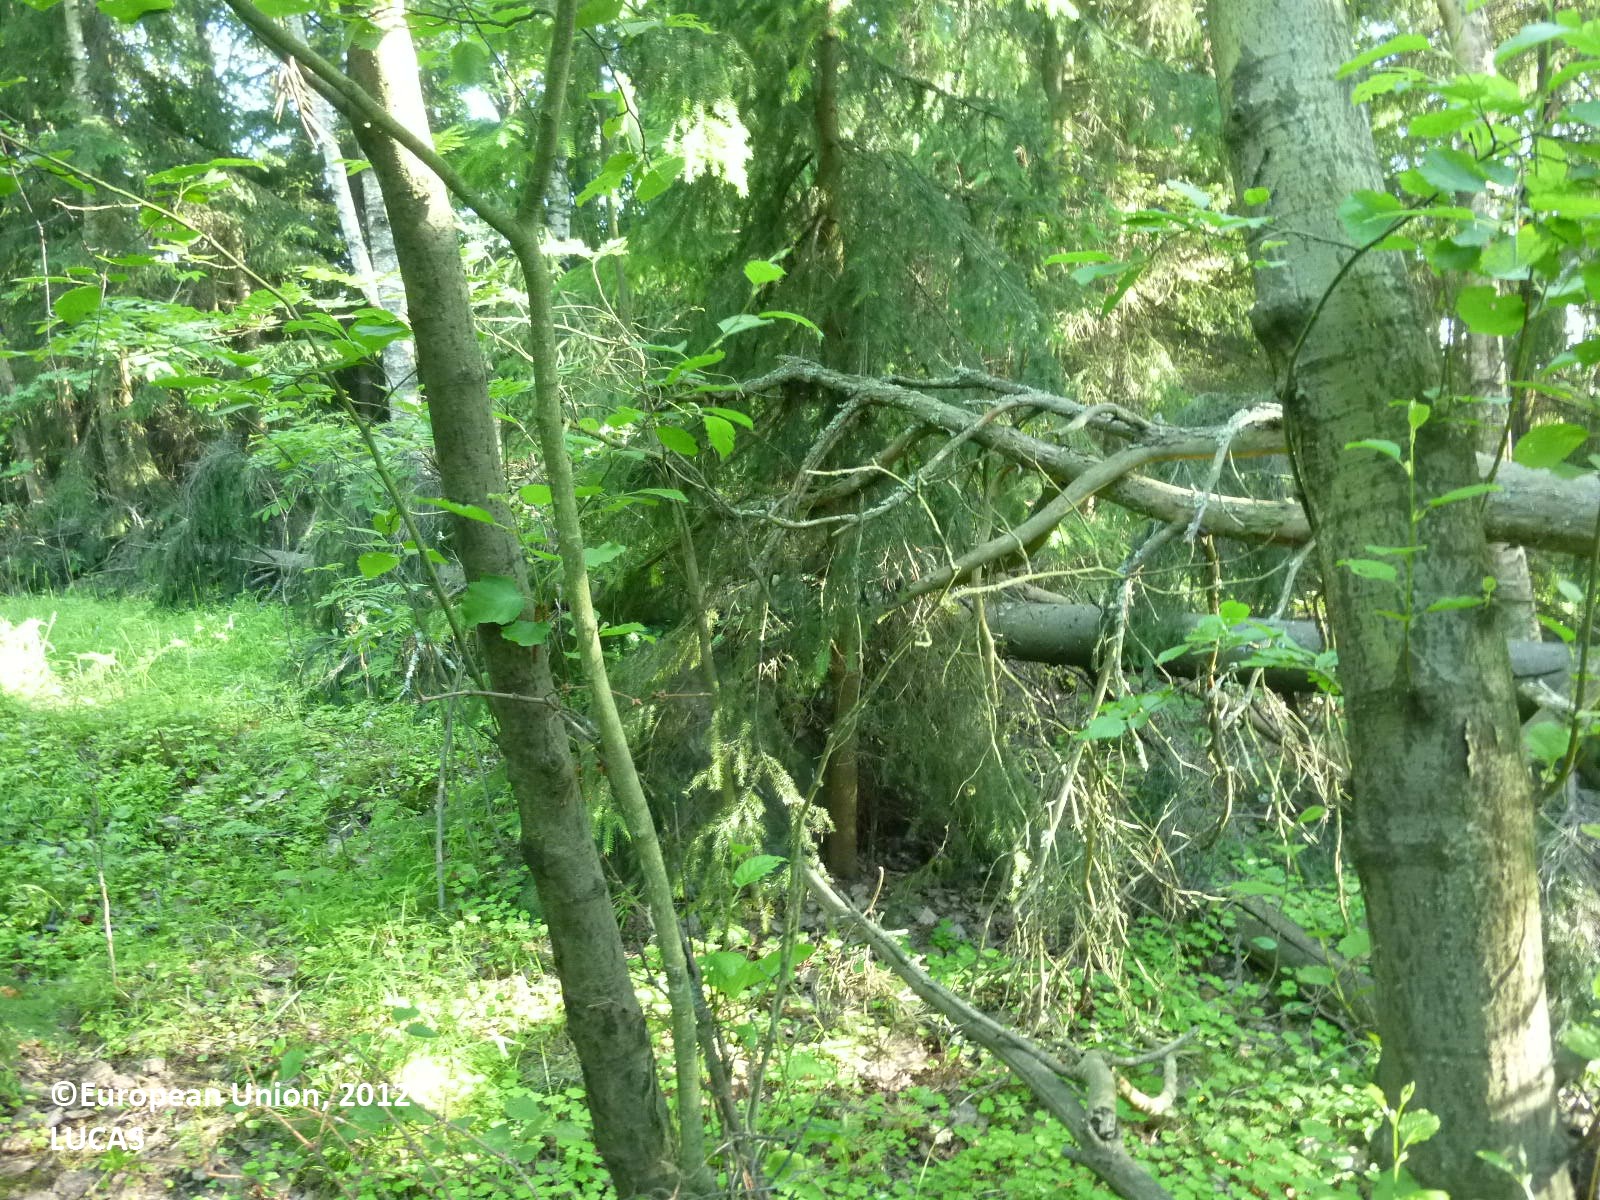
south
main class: Woodland
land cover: Broadleaved woodland
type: boreal forest
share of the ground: 50 - 75 %
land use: Forestry
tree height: > 5 m
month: July
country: FI
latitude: 61.3418
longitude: 22.0397
